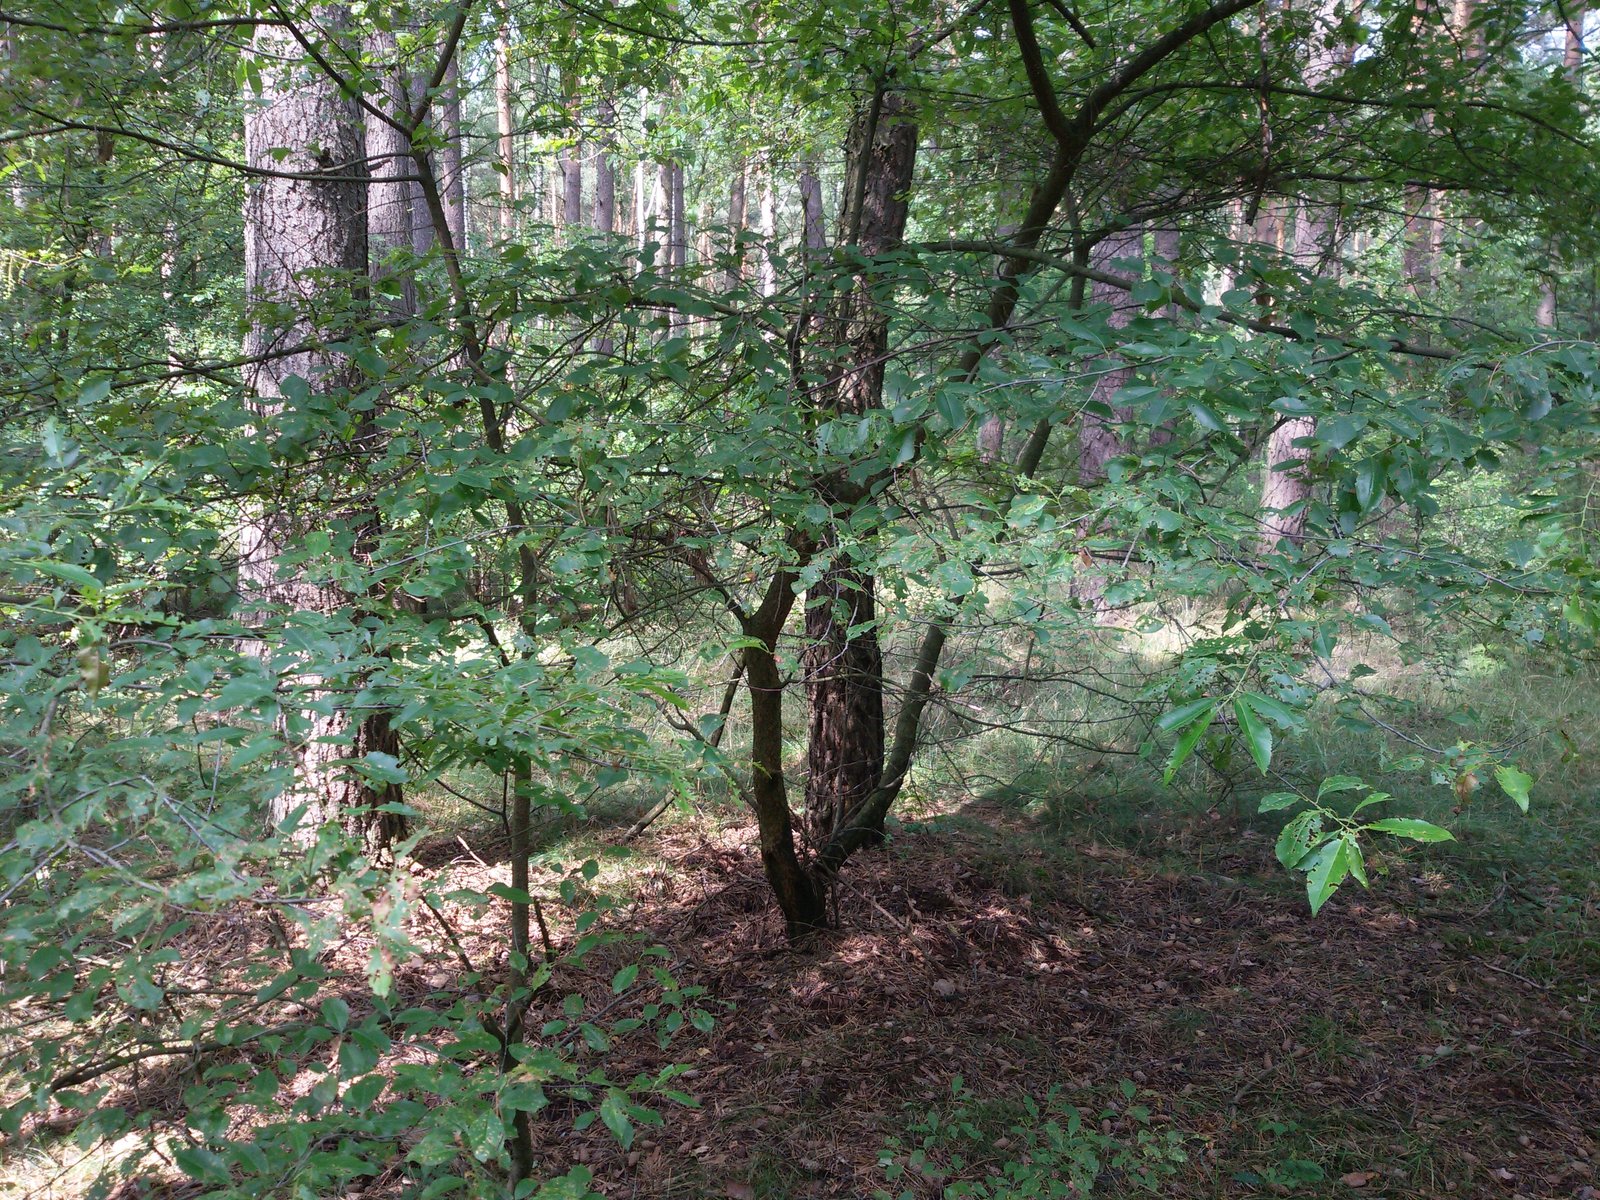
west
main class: Woodland
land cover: Pine dominated mixed woodland
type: hemiboreal forest and nemoral coniferous forest and mixed broadleaved-coniferous forest
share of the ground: > 75 %
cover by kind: coniferous forest trees 60 %, broadleaved forest trees 20 %, shrubs 10 %, herbaceous plants 10 %
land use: Forestry
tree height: > 5 m
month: July
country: PL
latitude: 52.6397
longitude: 17.5939
